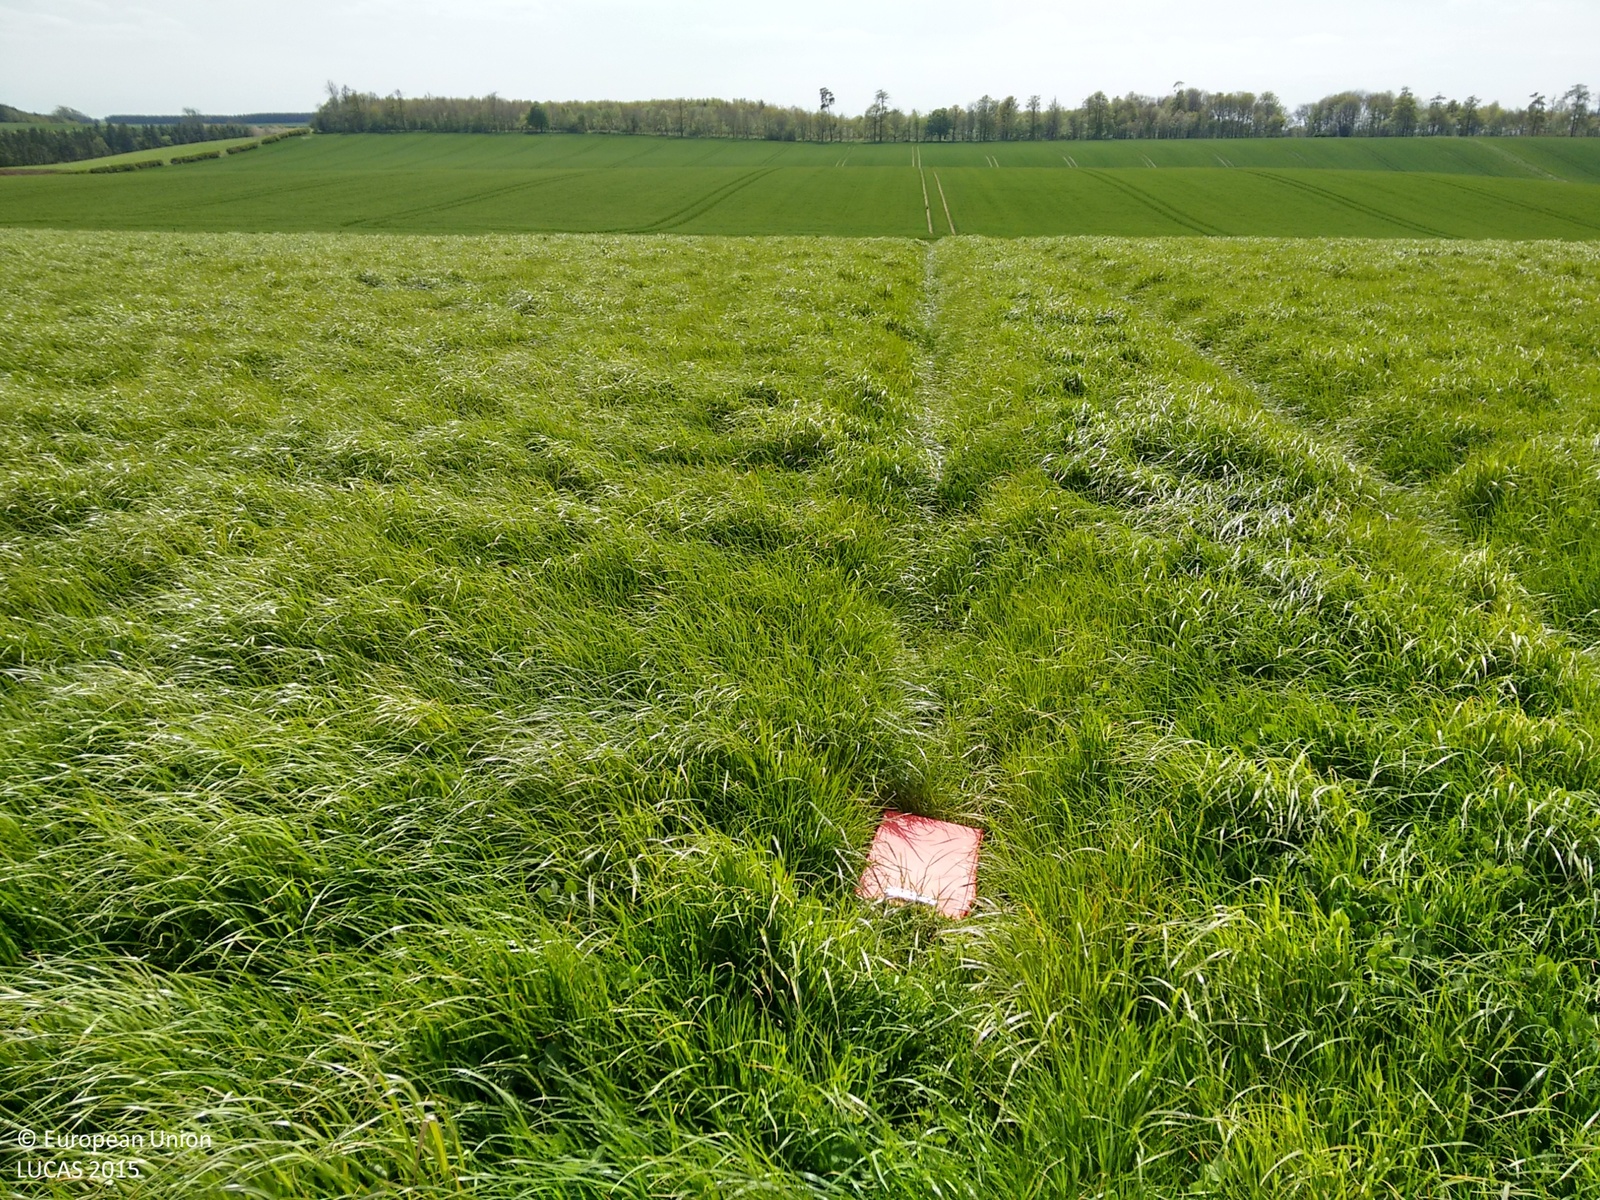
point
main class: Cropland
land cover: Barley
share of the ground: > 75 %
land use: Agriculture (excluding fallow land and kitchen gardens)
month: May
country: GB
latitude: 55.7799
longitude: -2.2533
